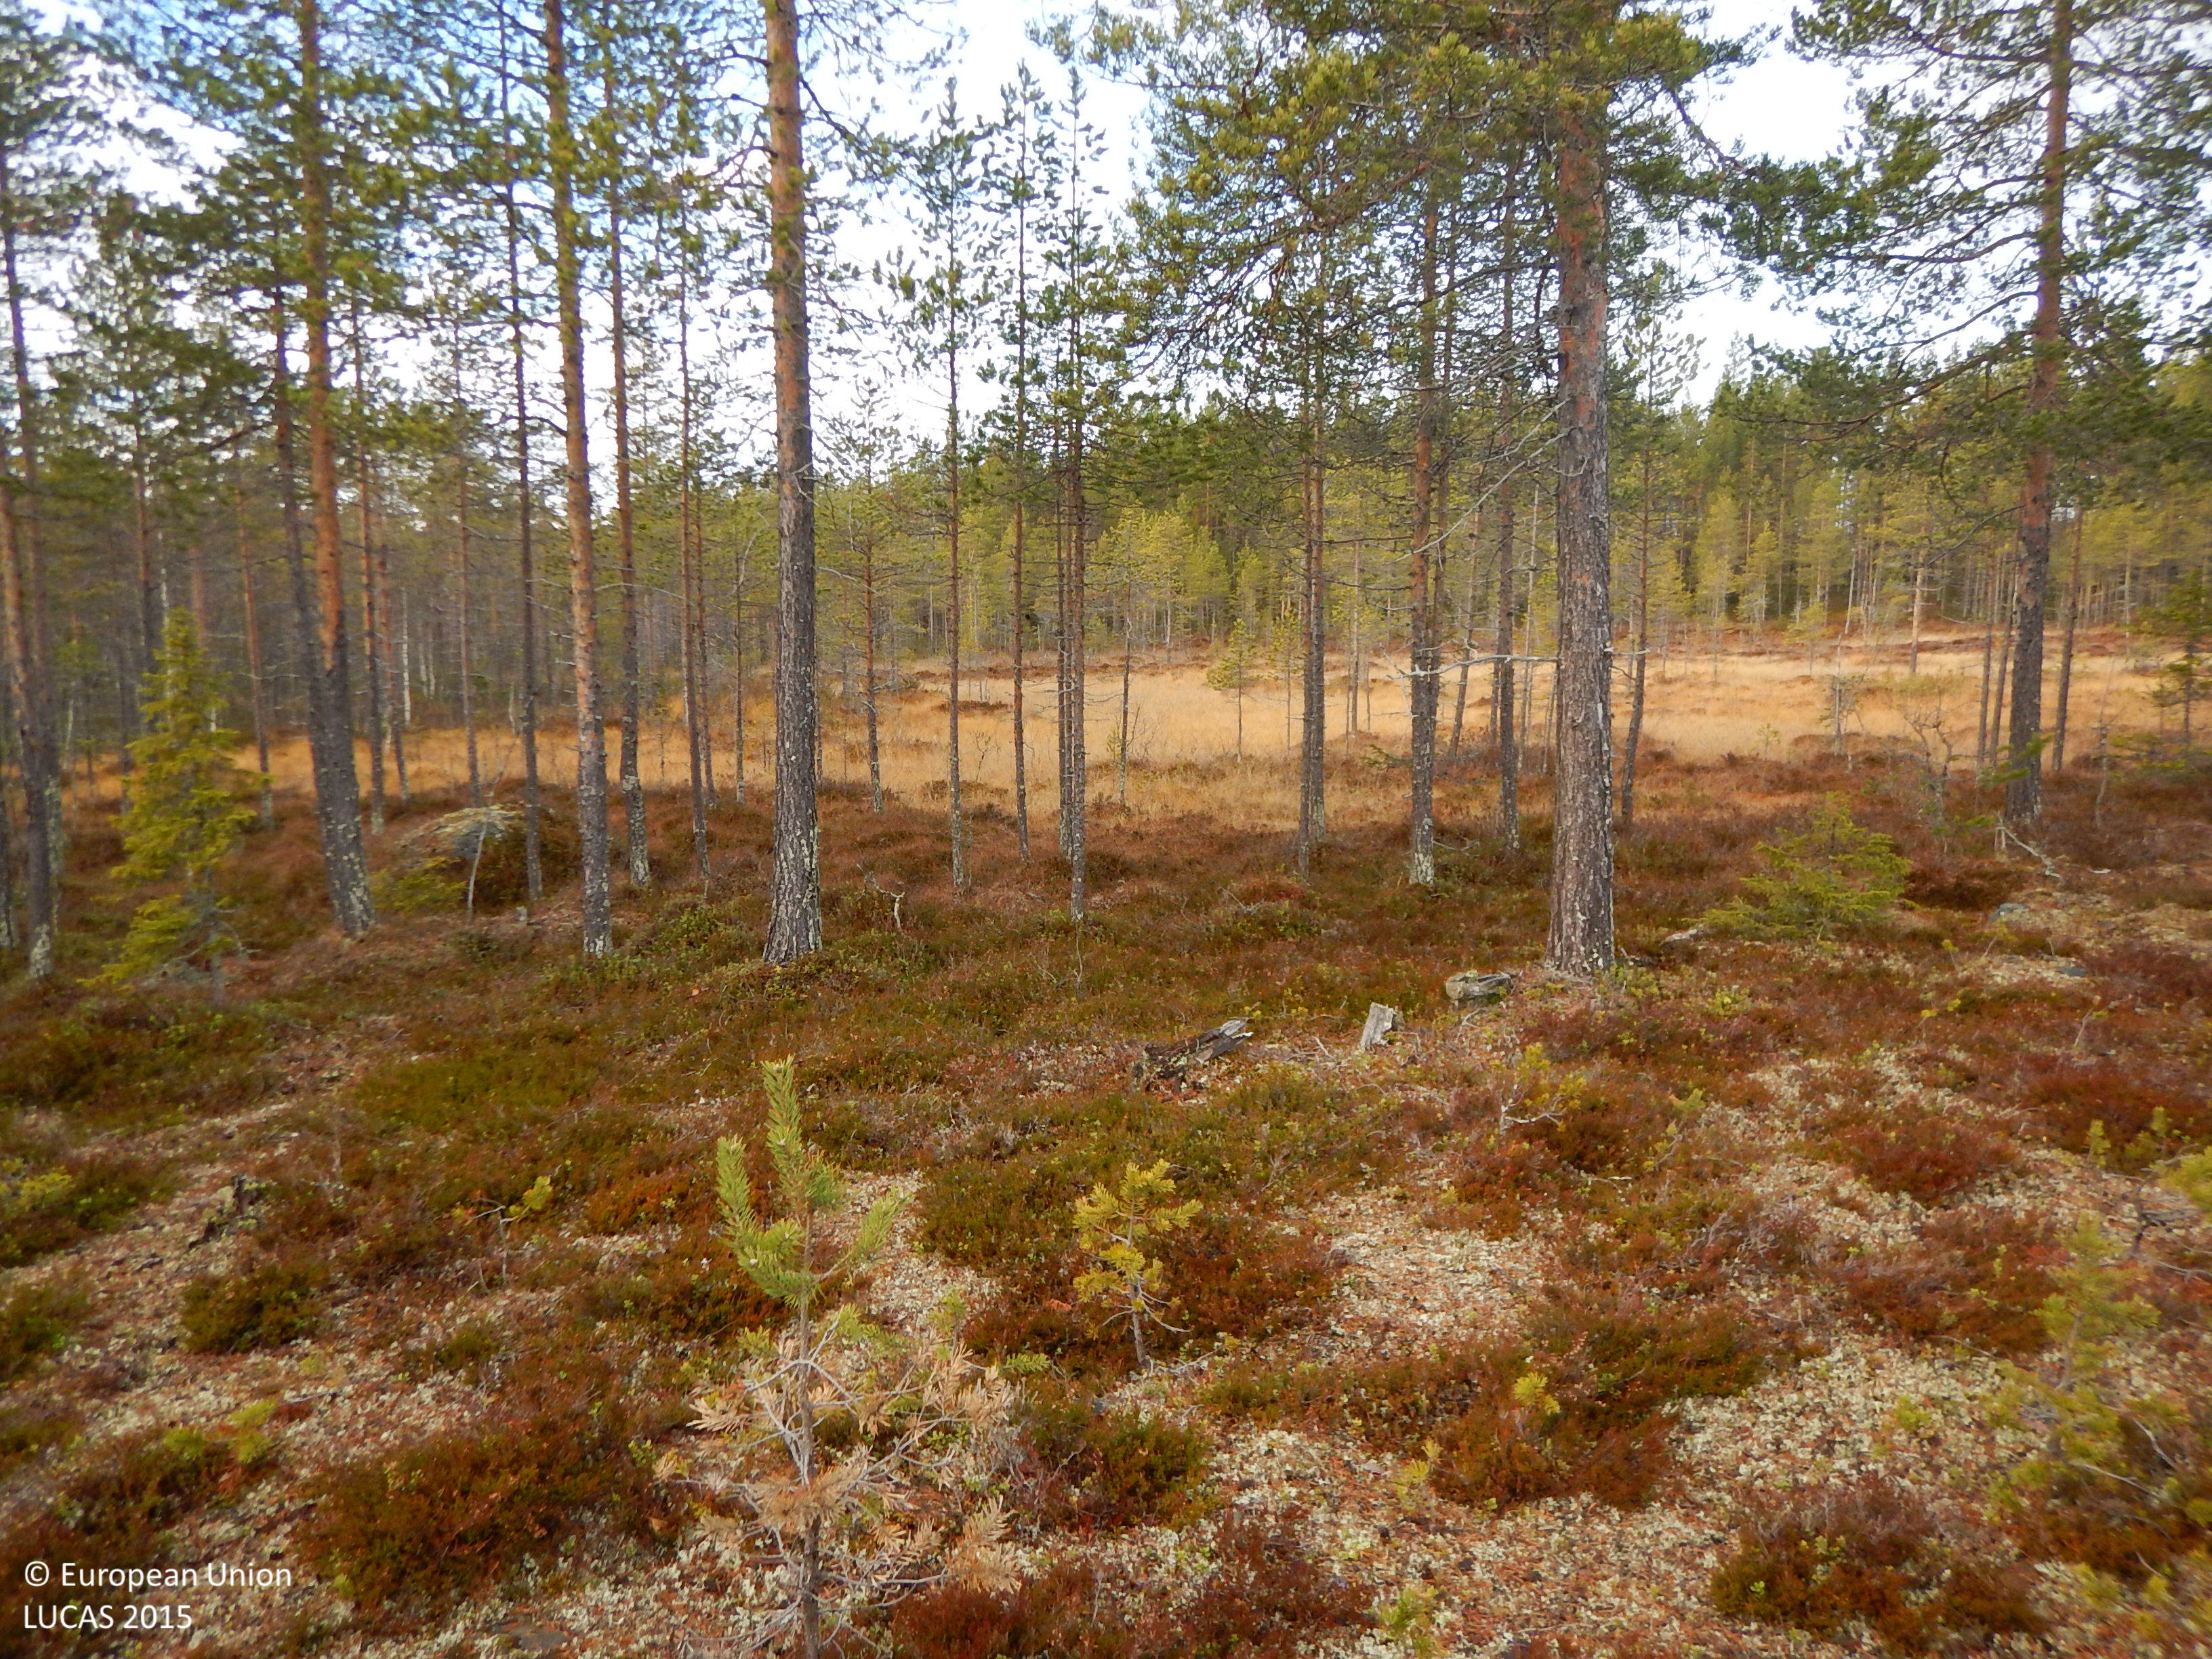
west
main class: Woodland
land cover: Pine dominated coniferous woodland
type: boreal forest
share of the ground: 10 - 25 %
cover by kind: shrubs 50 %, coniferous forest trees 25 %, lichens and mosses 20 %, herbaceous plants 5 %
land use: Forestry
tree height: < 5 m
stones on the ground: < 10 %
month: October
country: SE
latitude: 65.2818
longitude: 20.0617
